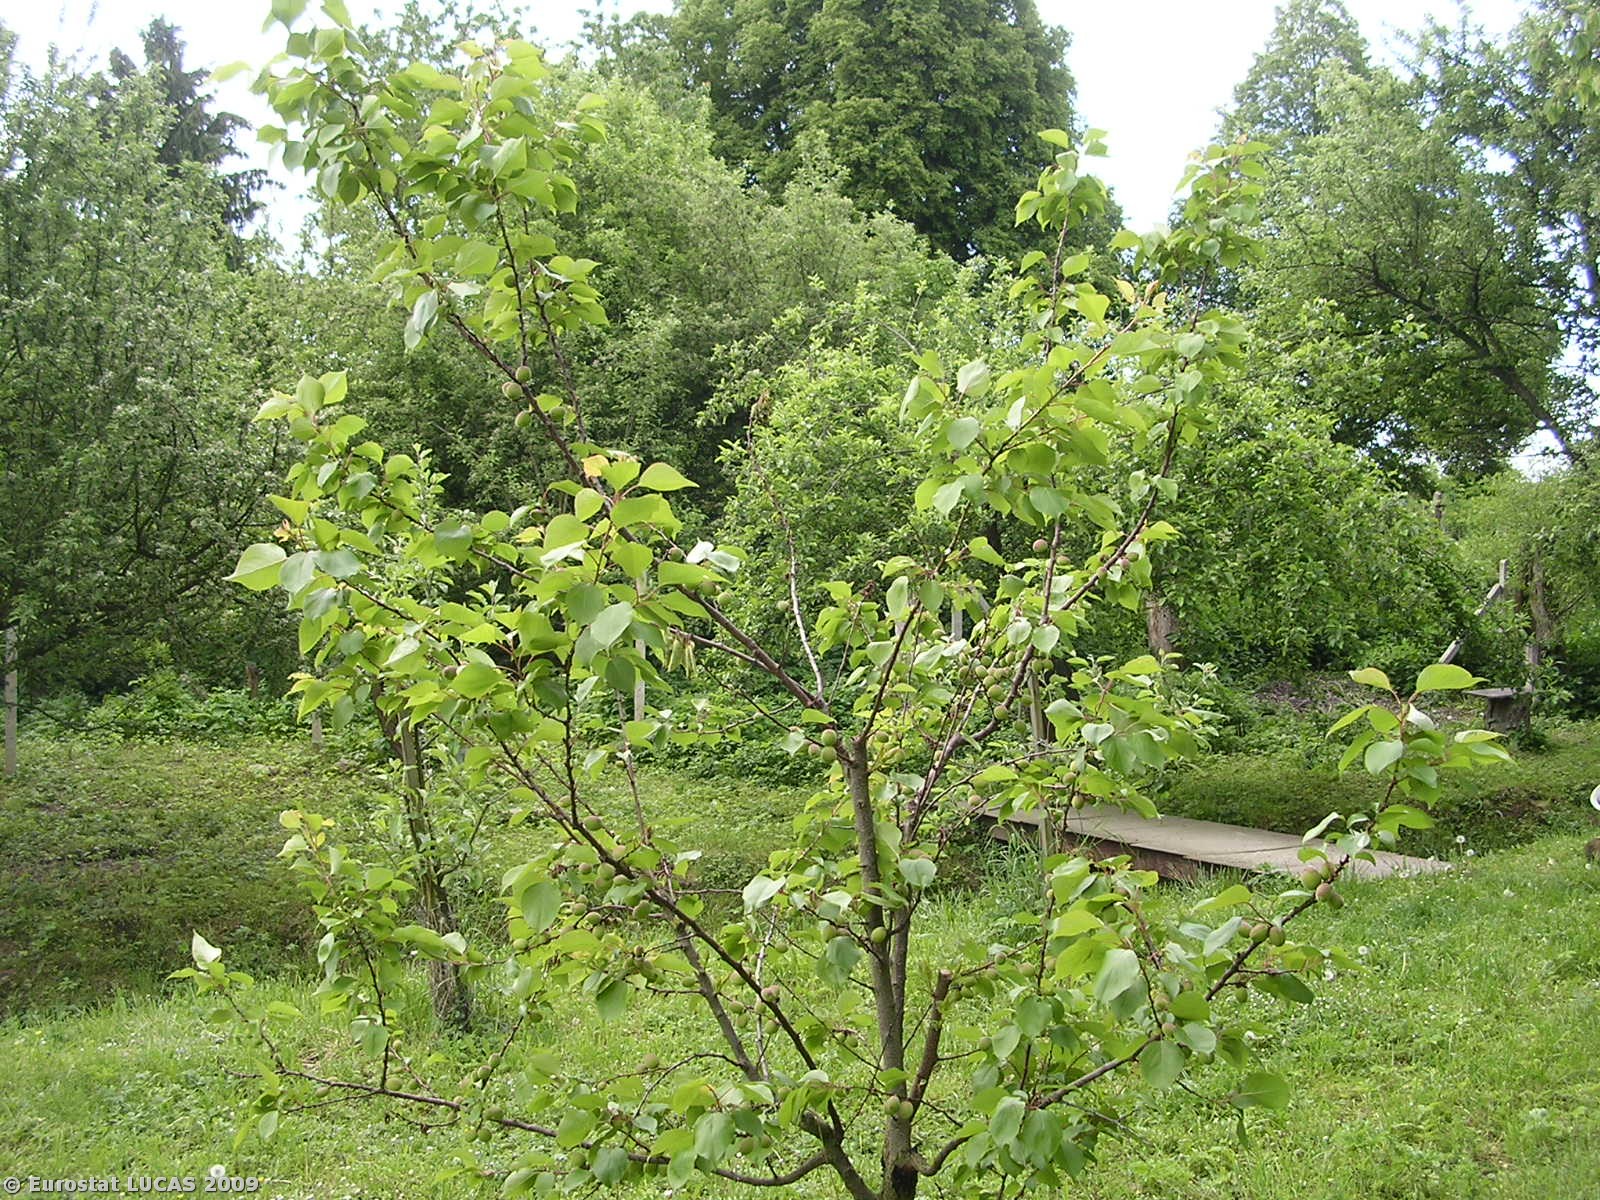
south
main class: Cropland
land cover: Other fruit trees and berries
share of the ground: 25 - 50 %
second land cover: Grassland with sparse tree/shrub cover
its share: > 75 %
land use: Kitchen garden
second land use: Residential
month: May
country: CZ
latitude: 49.9636
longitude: 14.6441
